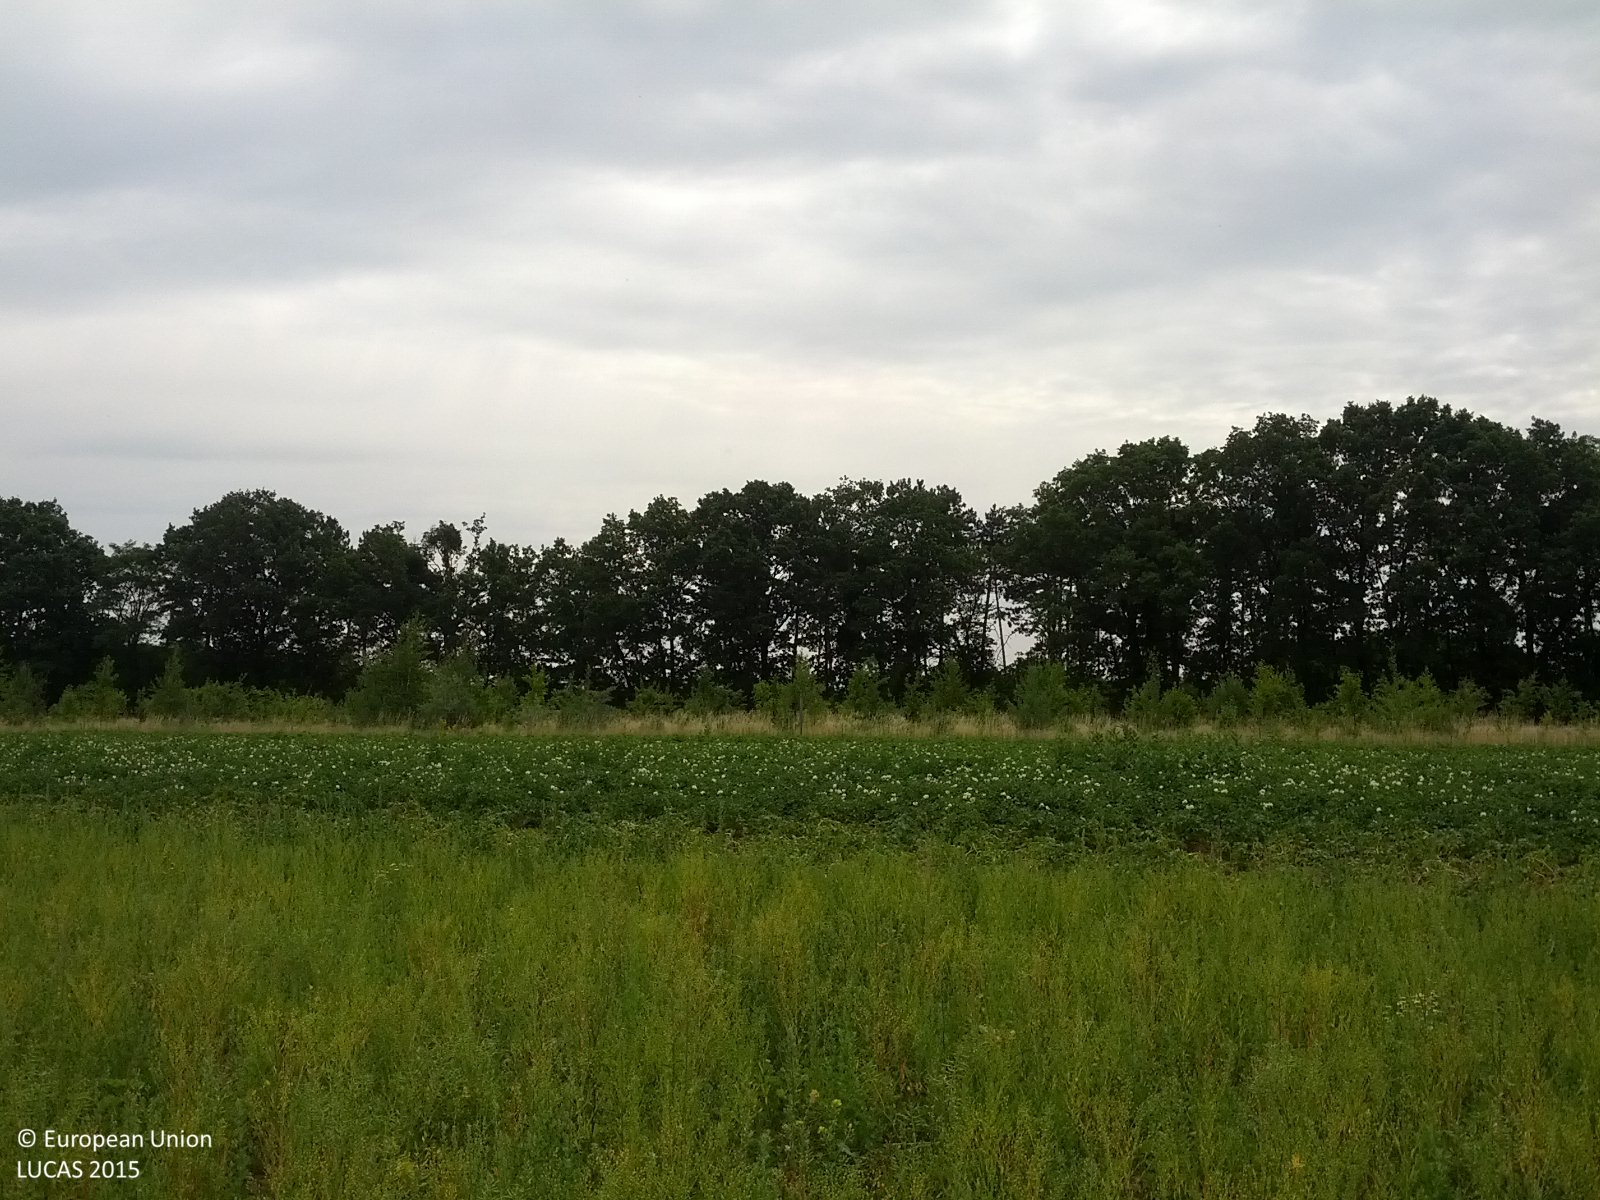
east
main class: Cropland
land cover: Clovers
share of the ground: 25 - 50 %
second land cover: Other fibre and oleaginous crops
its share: 25 - 50 %
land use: Agriculture (excluding fallow land and kitchen gardens)
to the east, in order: Clovers; Other fibre and oleaginous crops; Potatoes; Fences; Nurseries; Fences; Abandoned hedges; Shrubland with sparse tree cover; Abandoned hedges; Grass margins; Sunflower; Common wheat
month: June
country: AT
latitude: 48.3178
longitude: 16.5463
